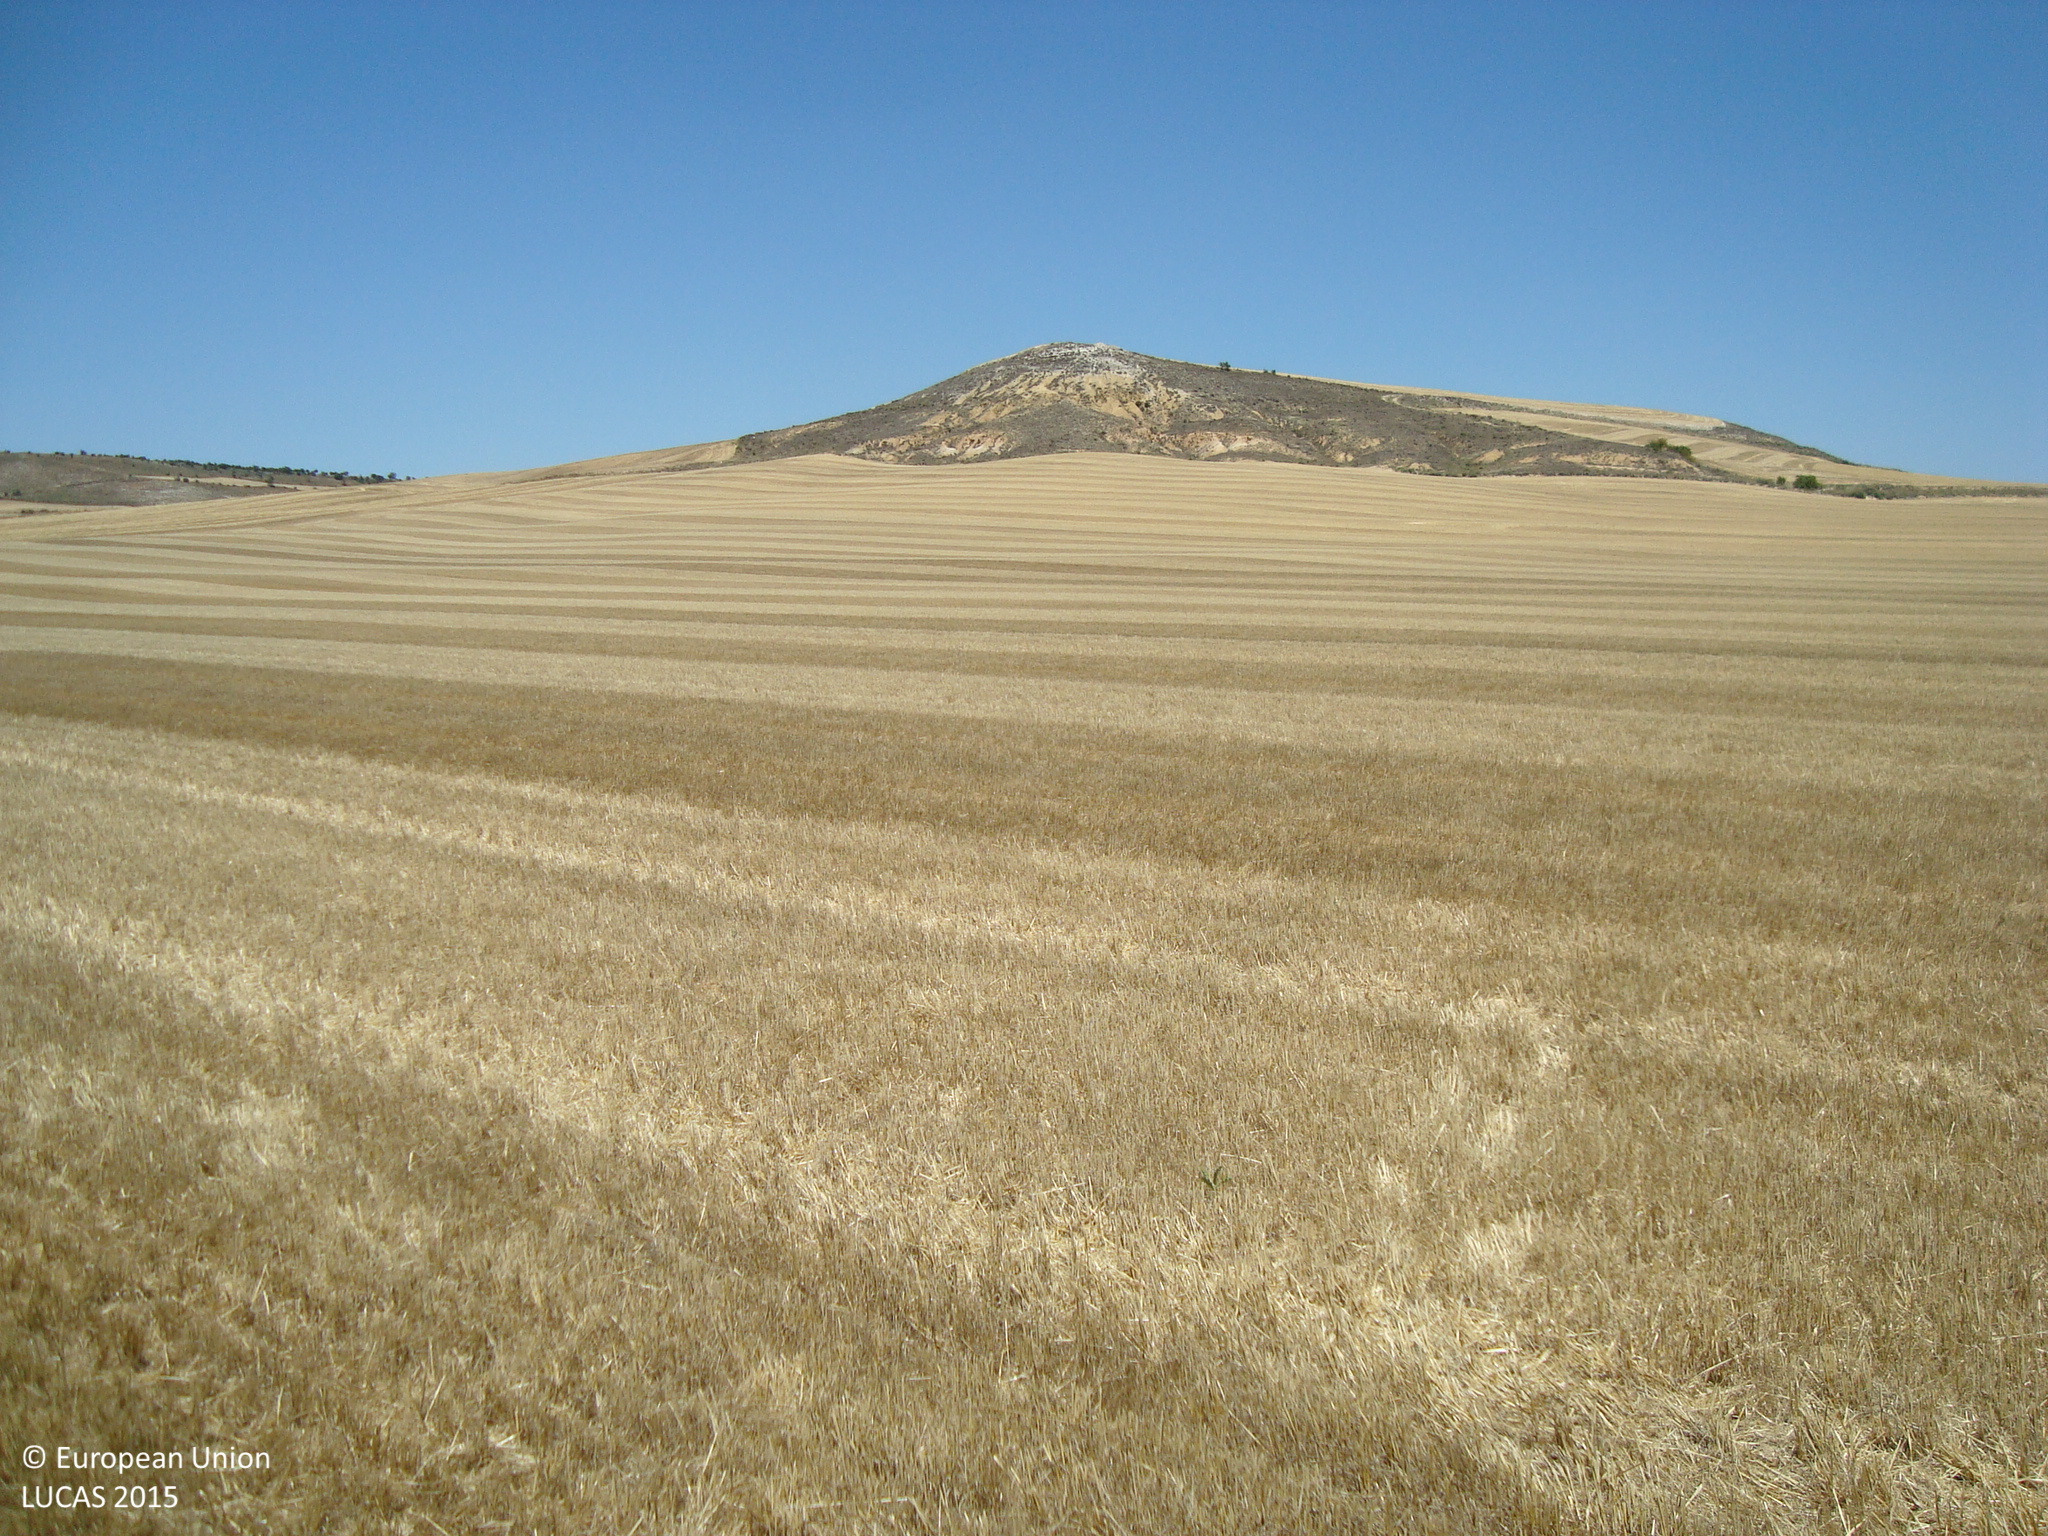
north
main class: Cropland
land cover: Barley
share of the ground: > 75 %
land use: Agriculture (excluding fallow land and kitchen gardens)
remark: Harvested field
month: July
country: ES
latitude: 42.0528
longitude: -4.3126
